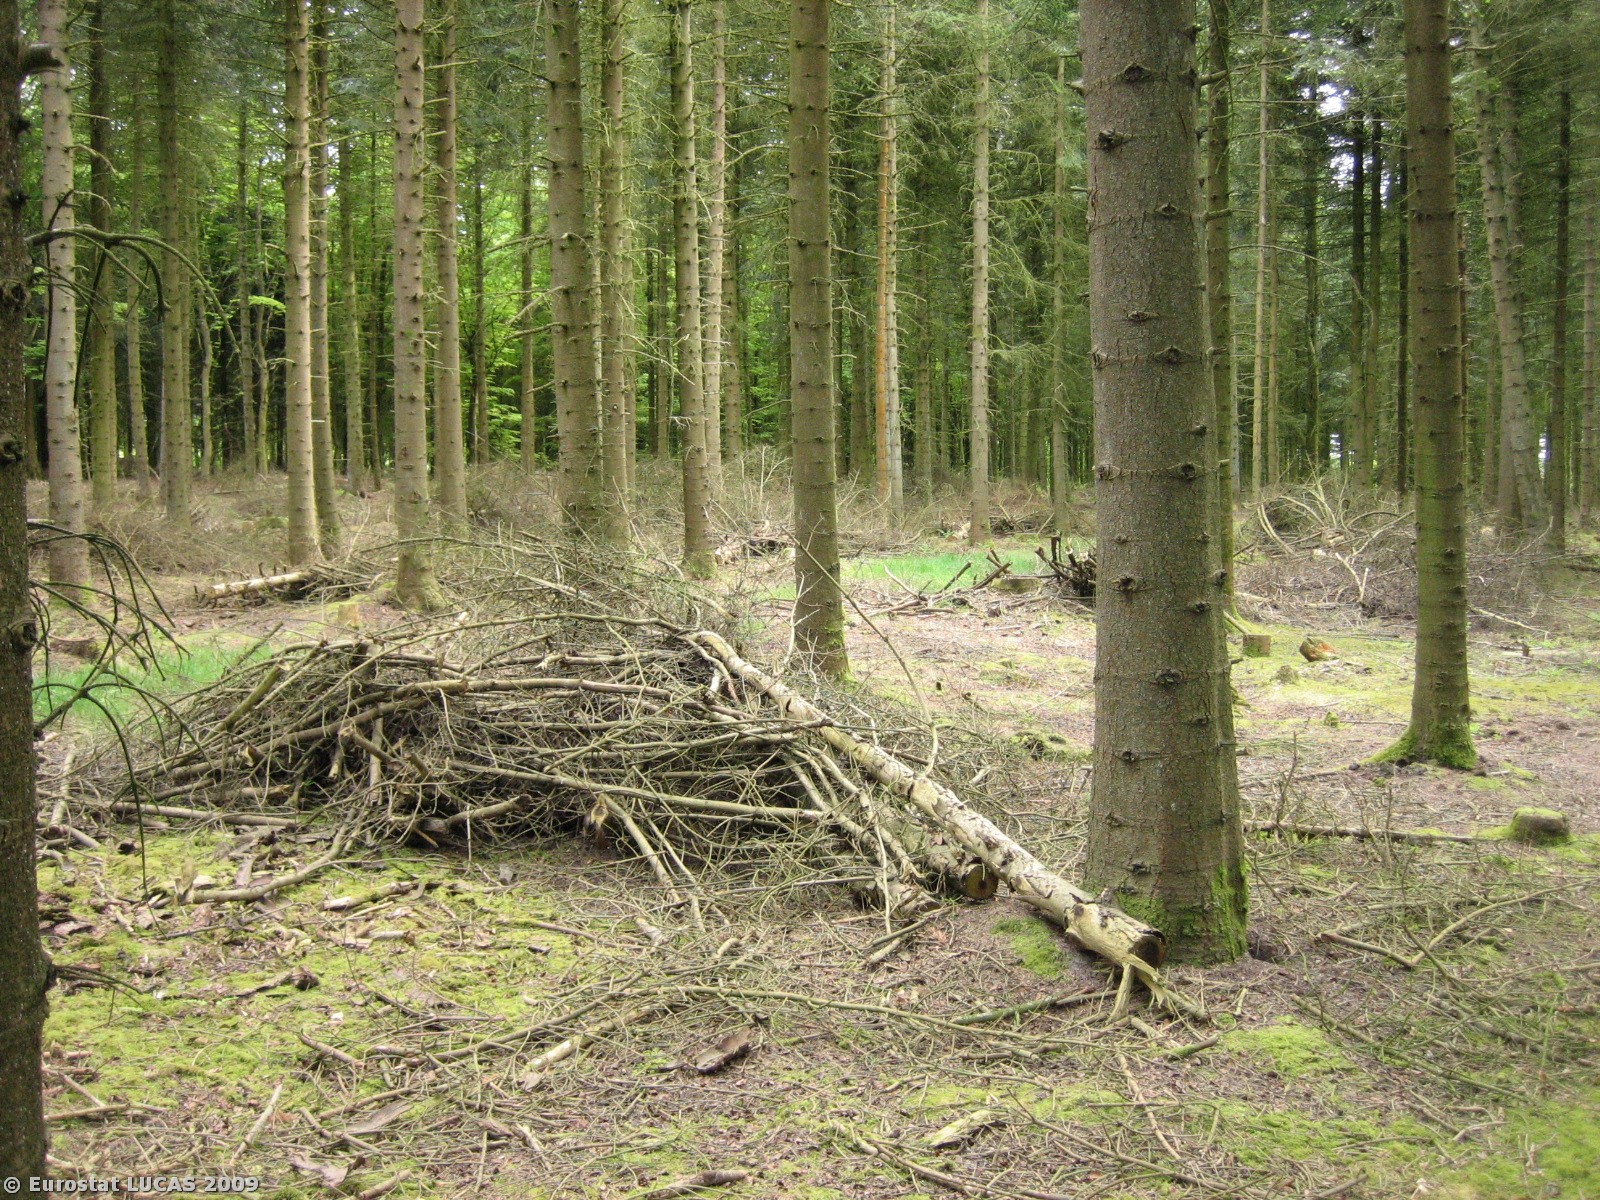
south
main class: Woodland
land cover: Coniferous woodland
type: hemiboreal forest and nemoral coniferous forest and mixed broadleaved-coniferous forest
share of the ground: > 75 %
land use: Forestry
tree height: > 5 m
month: May
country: DK
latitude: 56.1599
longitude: 8.4077
